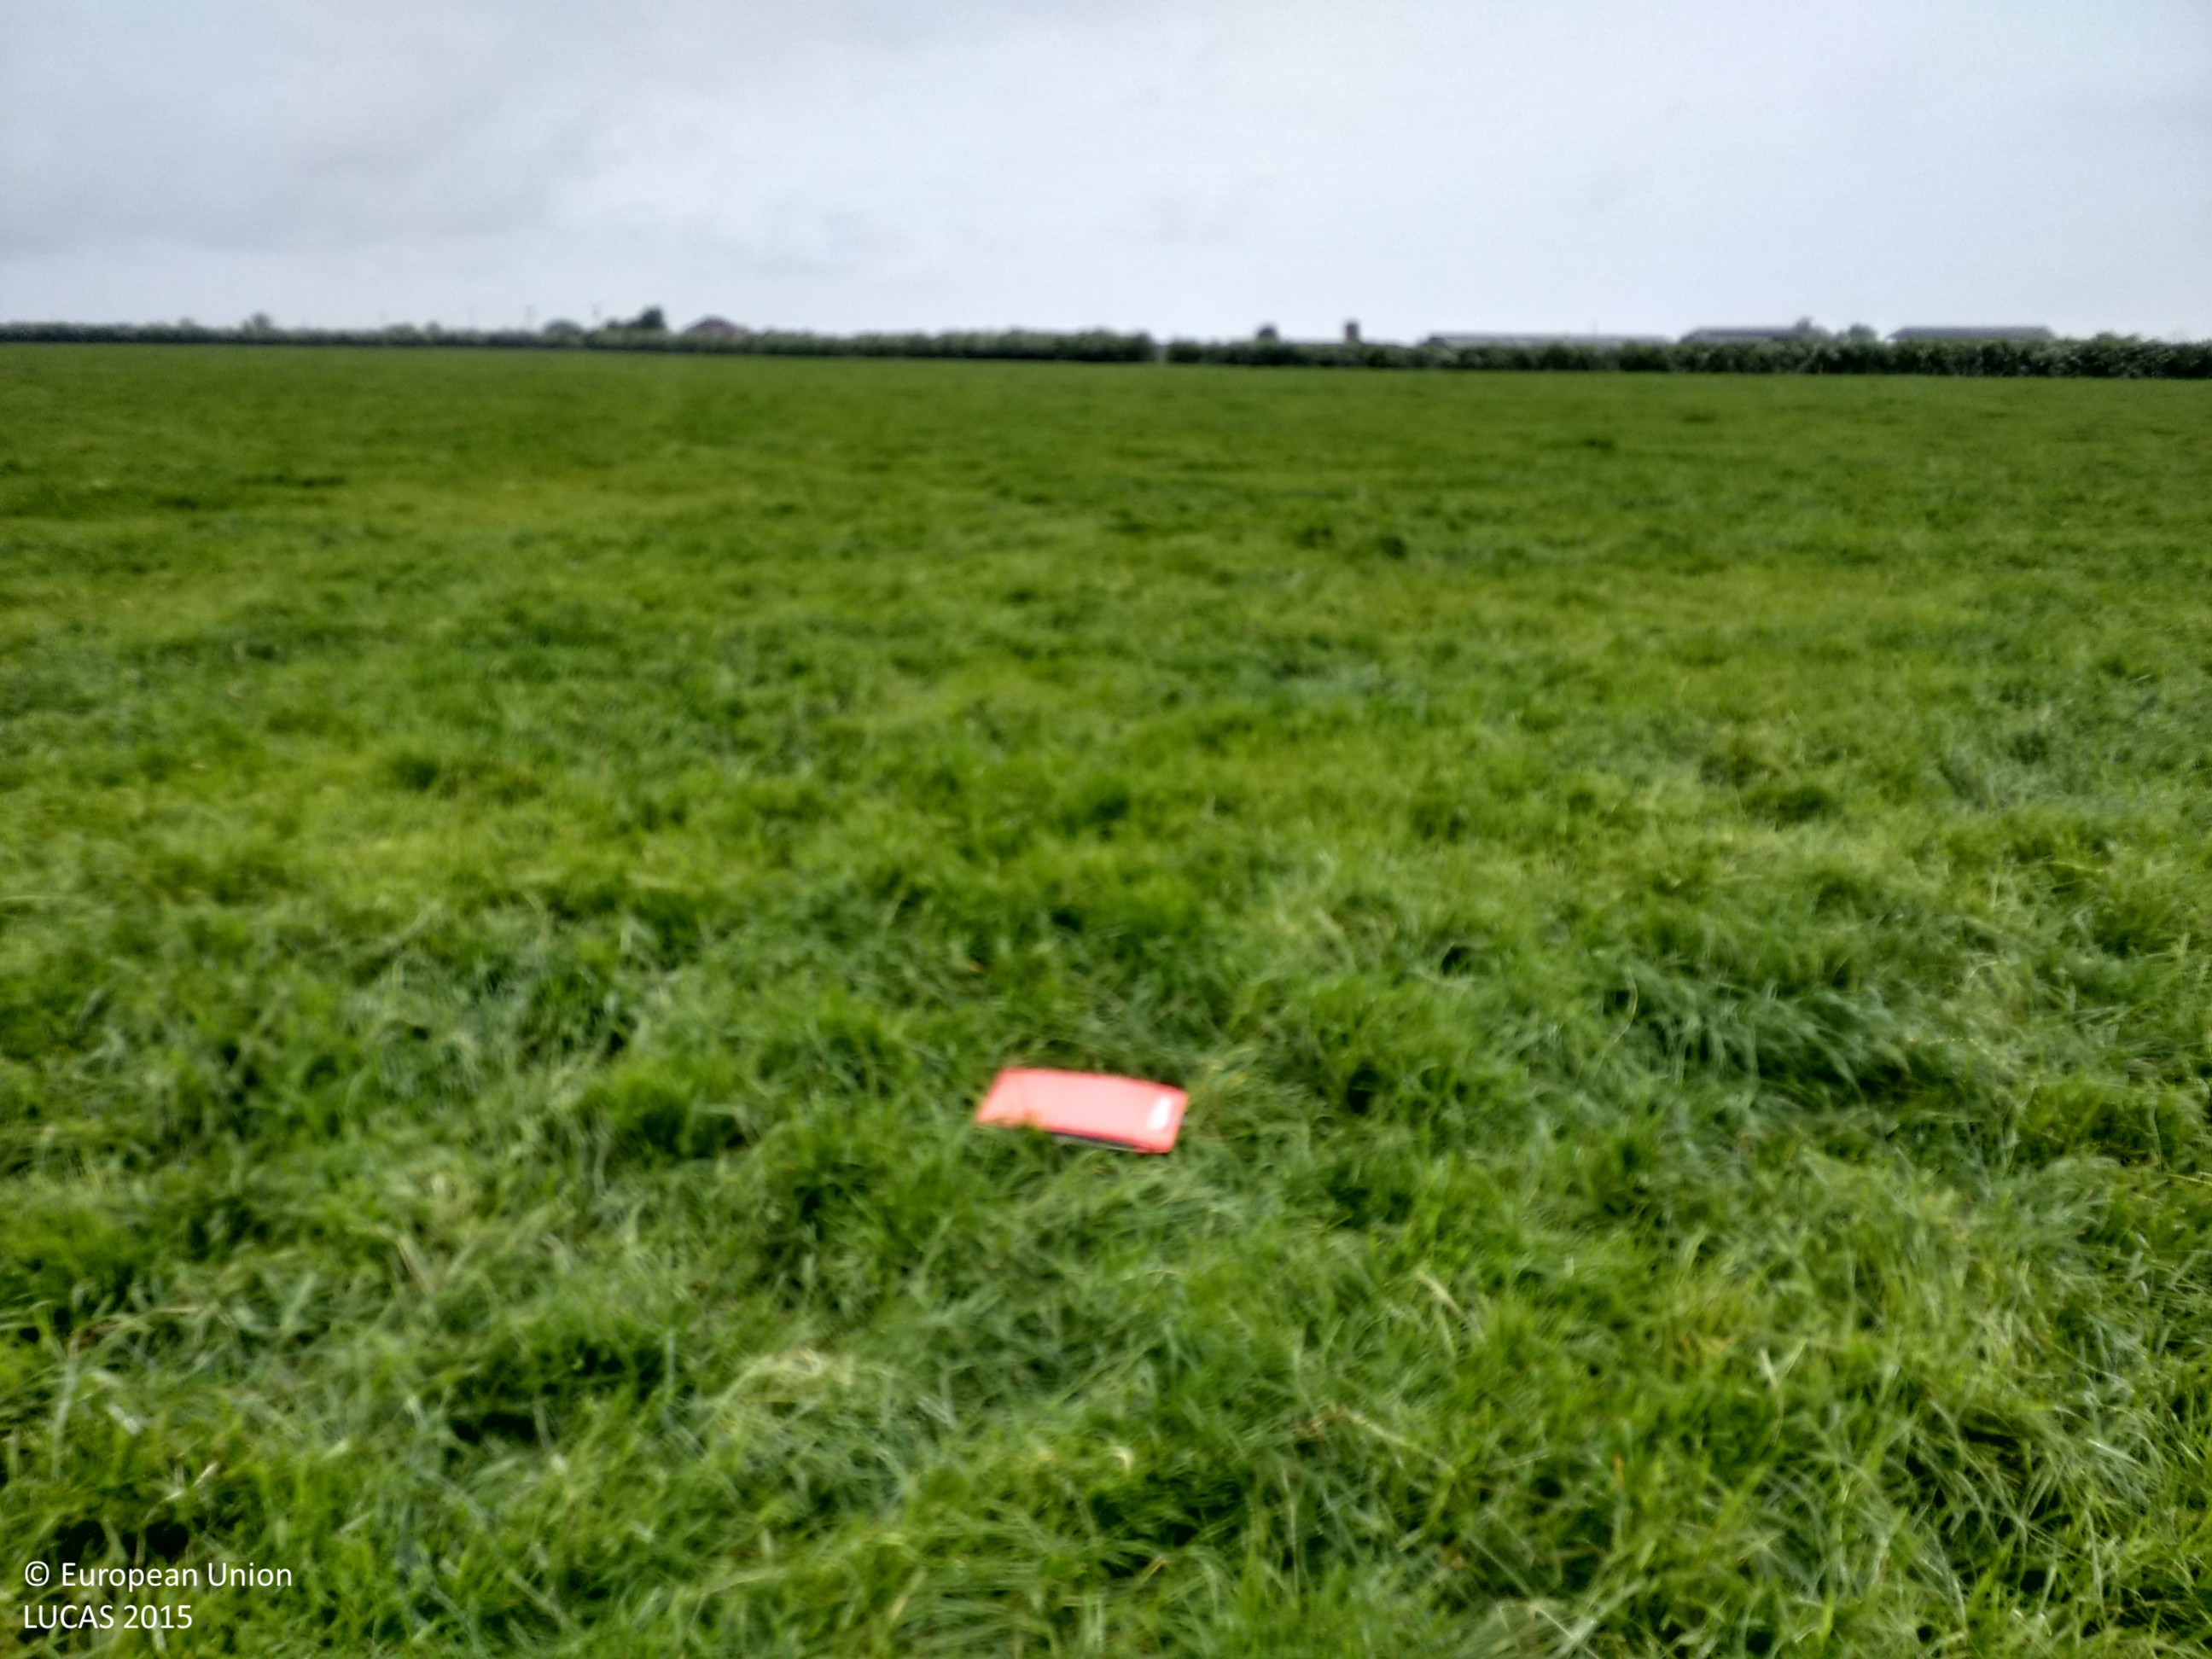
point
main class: Grassland
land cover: Grassland without tree/shrub cover
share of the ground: > 75 %
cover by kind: herbaceous plants 100 %
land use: Agriculture (excluding fallow land and kitchen gardens)
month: May
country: GB
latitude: 53.7057
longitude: -0.2904
